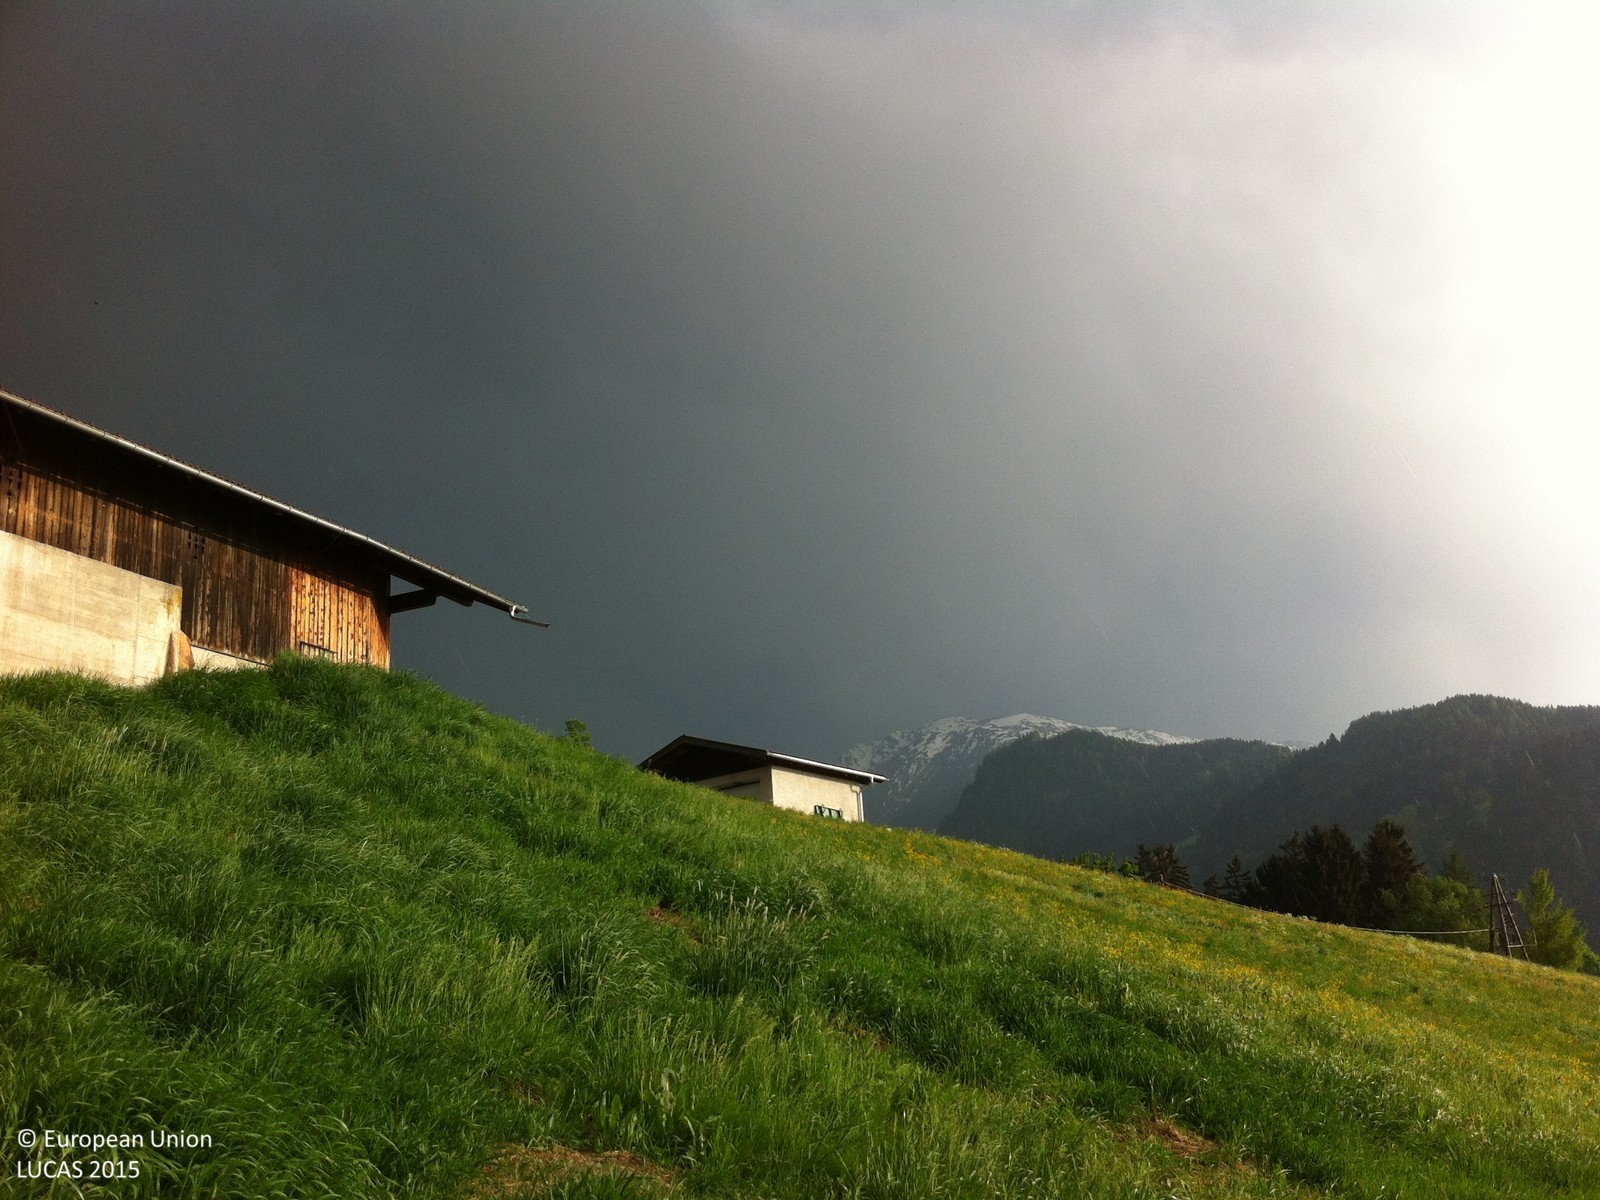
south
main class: Grassland
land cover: Grassland without tree/shrub cover
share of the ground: > 75 %
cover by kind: herbaceous plants 100 %
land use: Agriculture (excluding fallow land and kitchen gardens)
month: May
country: AT
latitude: 47.2762
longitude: 11.5717
